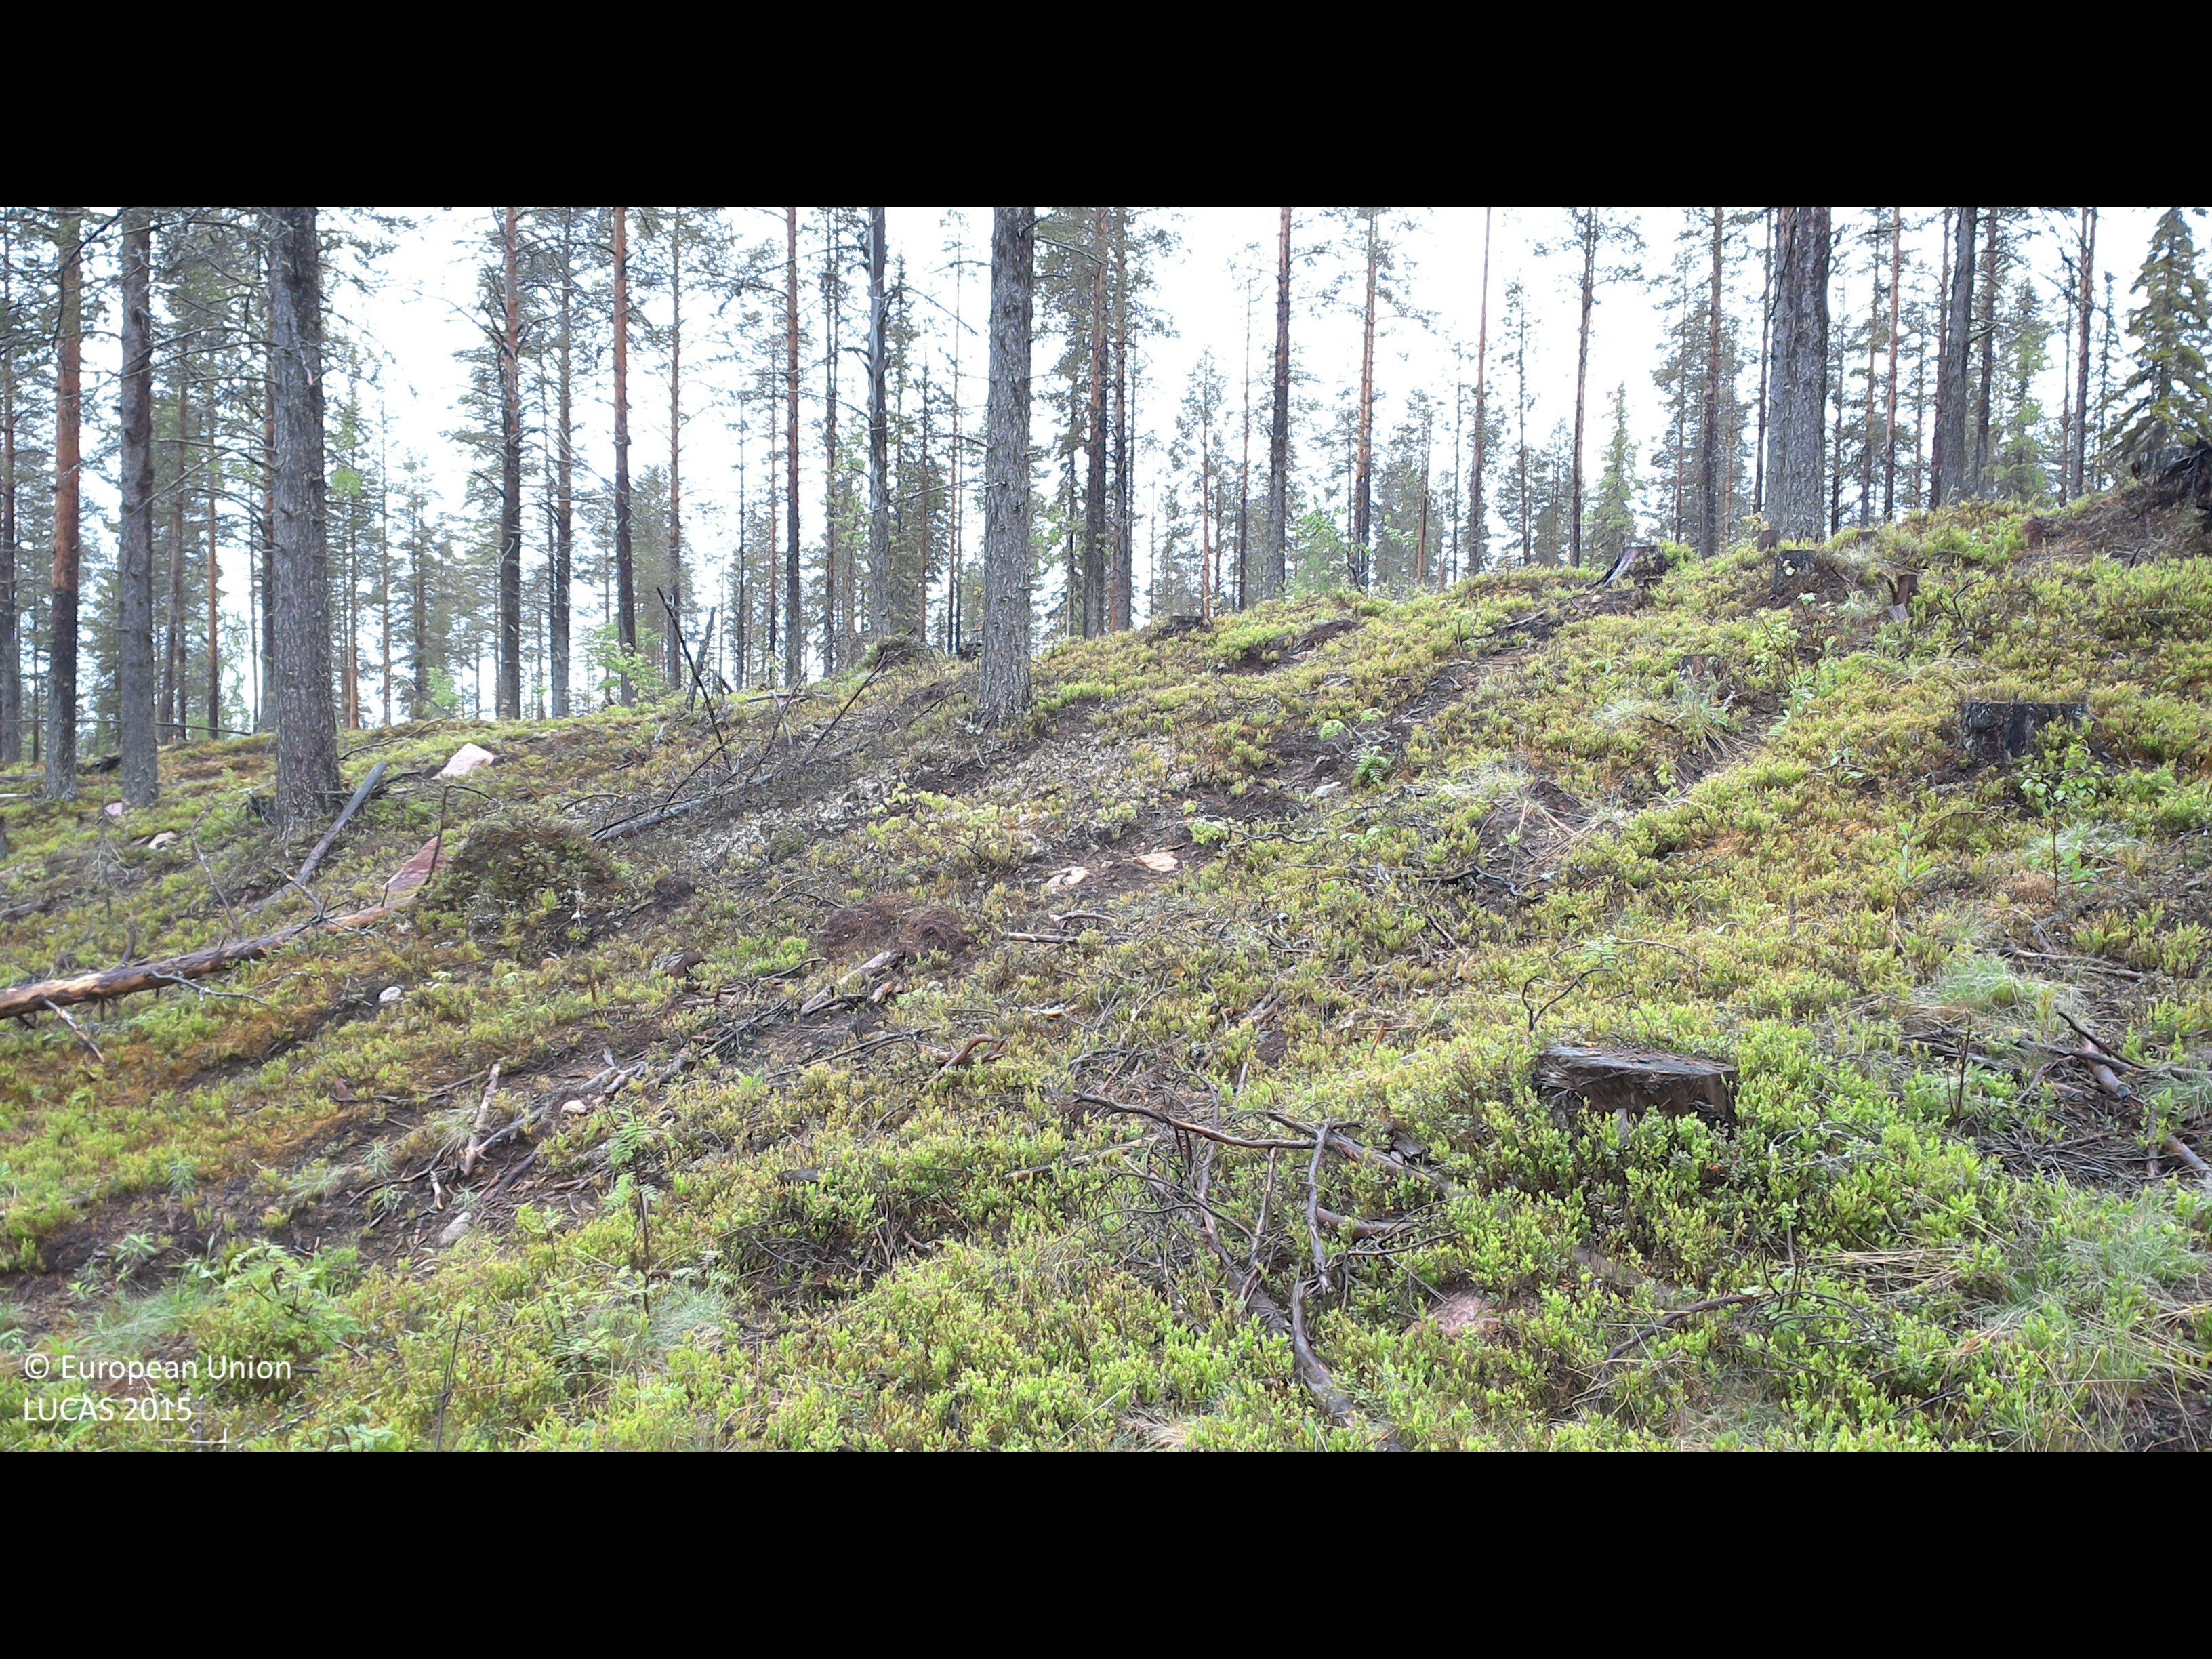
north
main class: Woodland
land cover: Pine dominated coniferous woodland
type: boreal forest
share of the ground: 10 - 25 %
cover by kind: shrubs 65 %, coniferous forest trees 20 %, lichens and mosses 10 %, unconsolidated bare surface 5 %
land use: Forestry
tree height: > 5 m
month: June
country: SE
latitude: 67.0211
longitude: 22.0111
